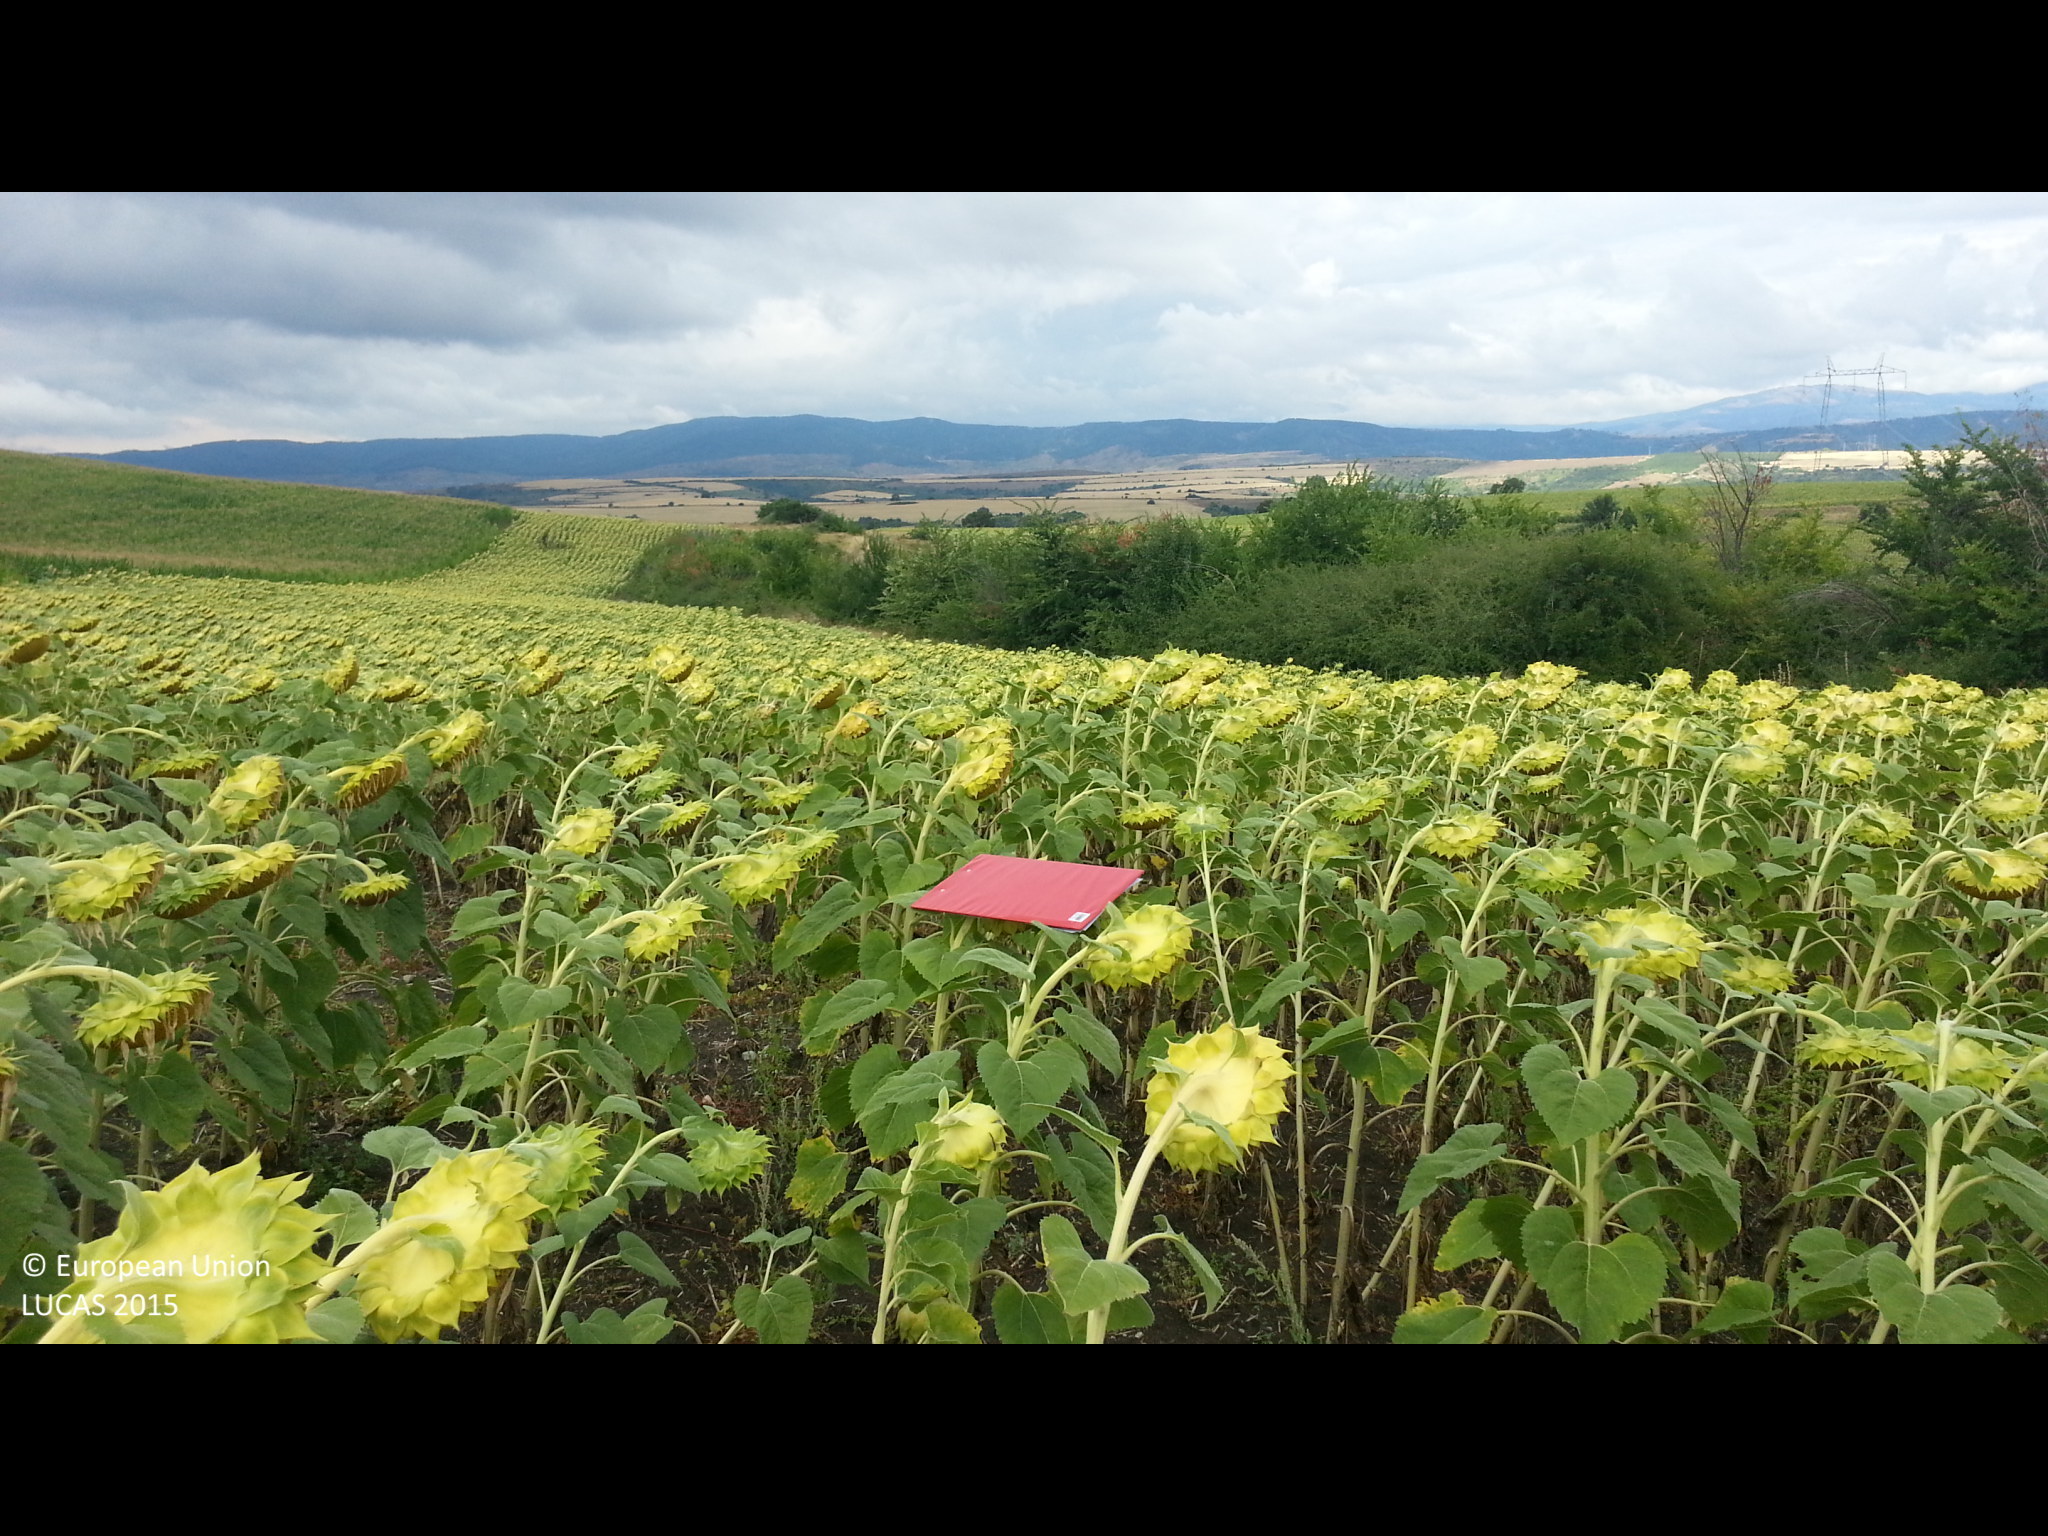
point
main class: Cropland
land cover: Sunflower
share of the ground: > 75 %
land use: Agriculture (excluding fallow land and kitchen gardens)
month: August
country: BG
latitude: 42.3094
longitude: 22.9701
